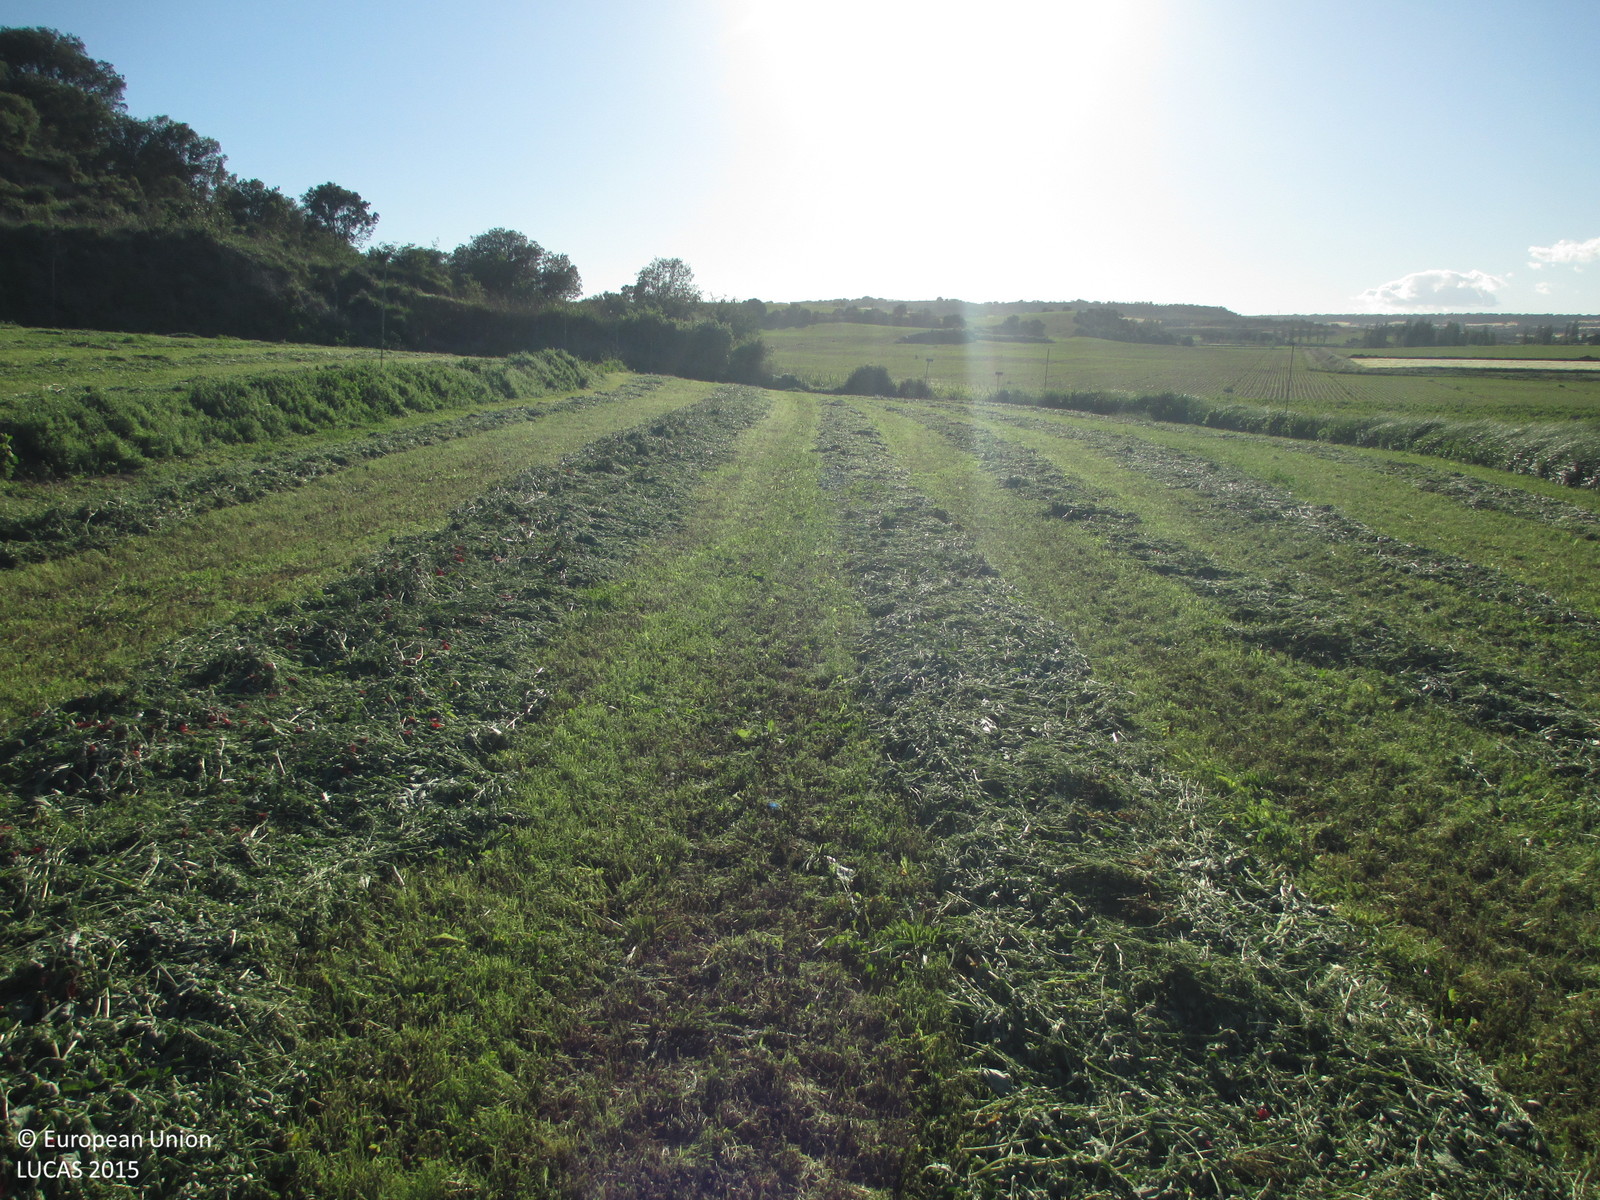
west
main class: Cropland
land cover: Lucerne
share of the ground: > 75 %
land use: Agriculture (excluding fallow land and kitchen gardens)
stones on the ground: < 10 %
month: May
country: ES
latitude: 42.0120
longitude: -0.0049
